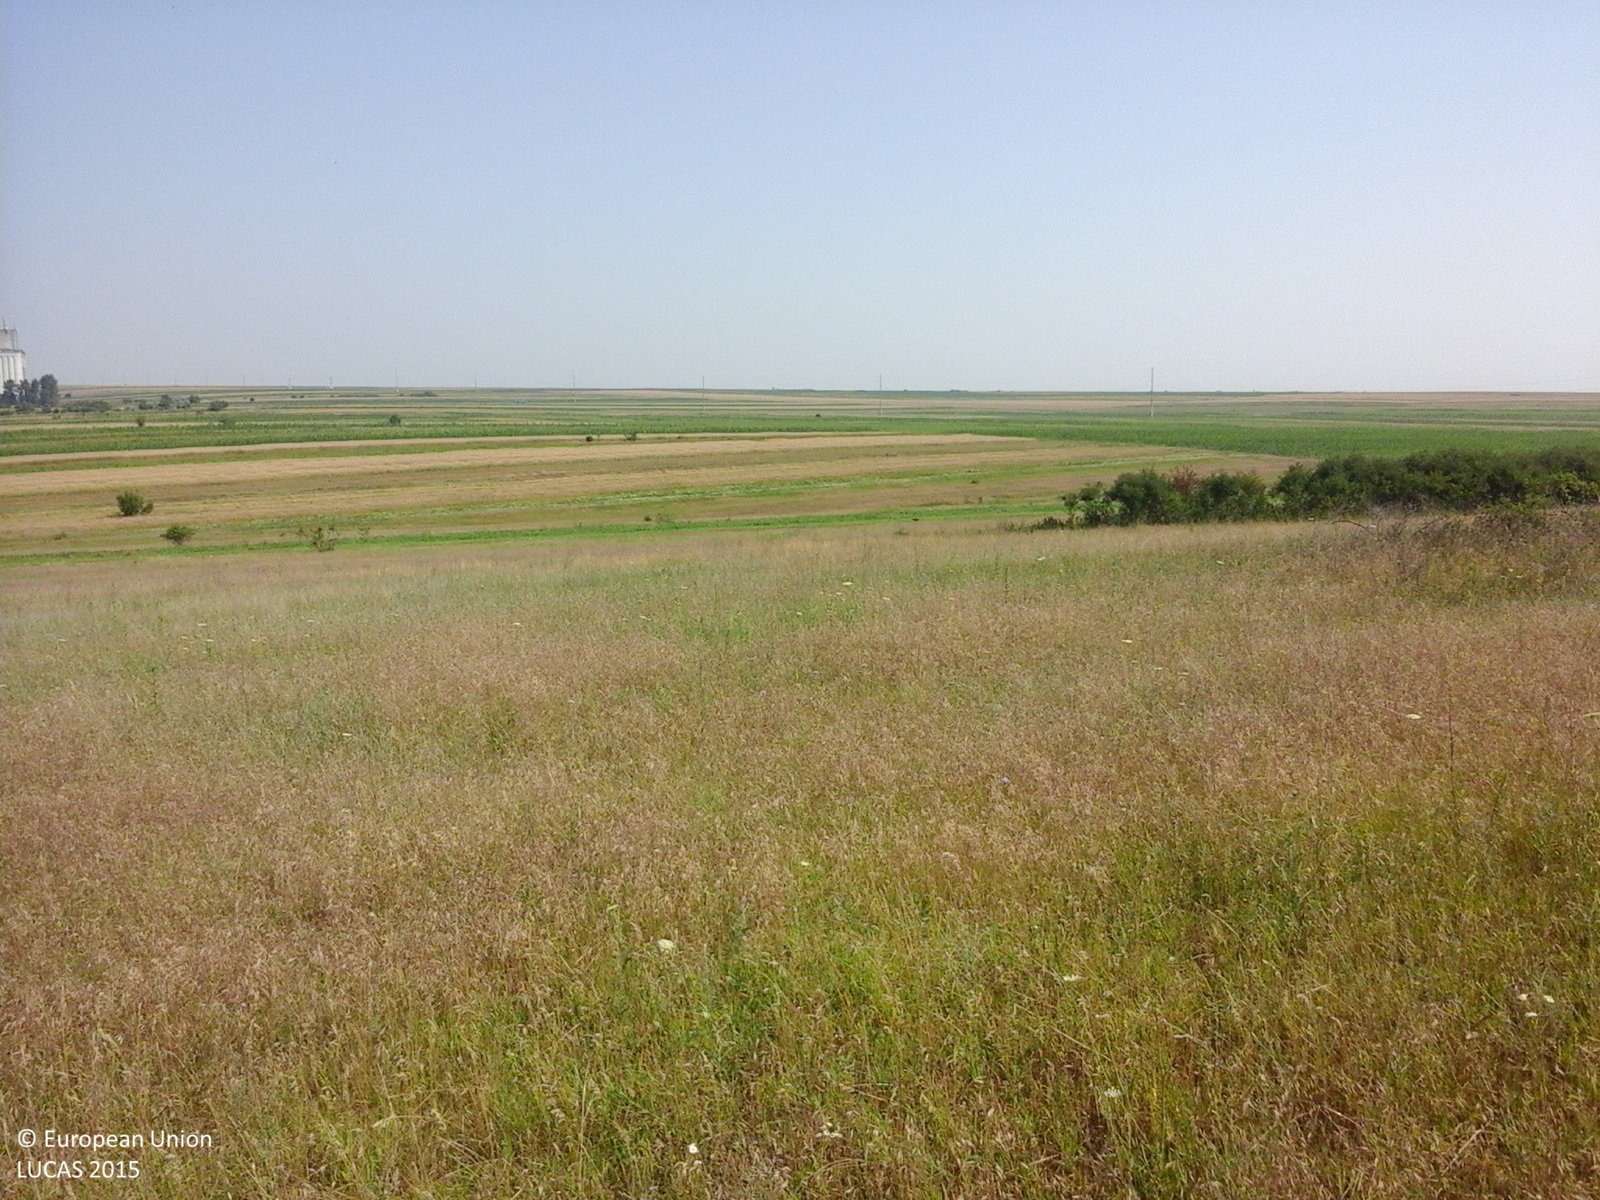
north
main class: Grassland
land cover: Grassland without tree/shrub cover
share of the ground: > 75 %
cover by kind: herbaceous plants 100 %
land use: Agriculture (excluding fallow land and kitchen gardens)
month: July
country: RO
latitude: 44.1784
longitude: 25.3072
